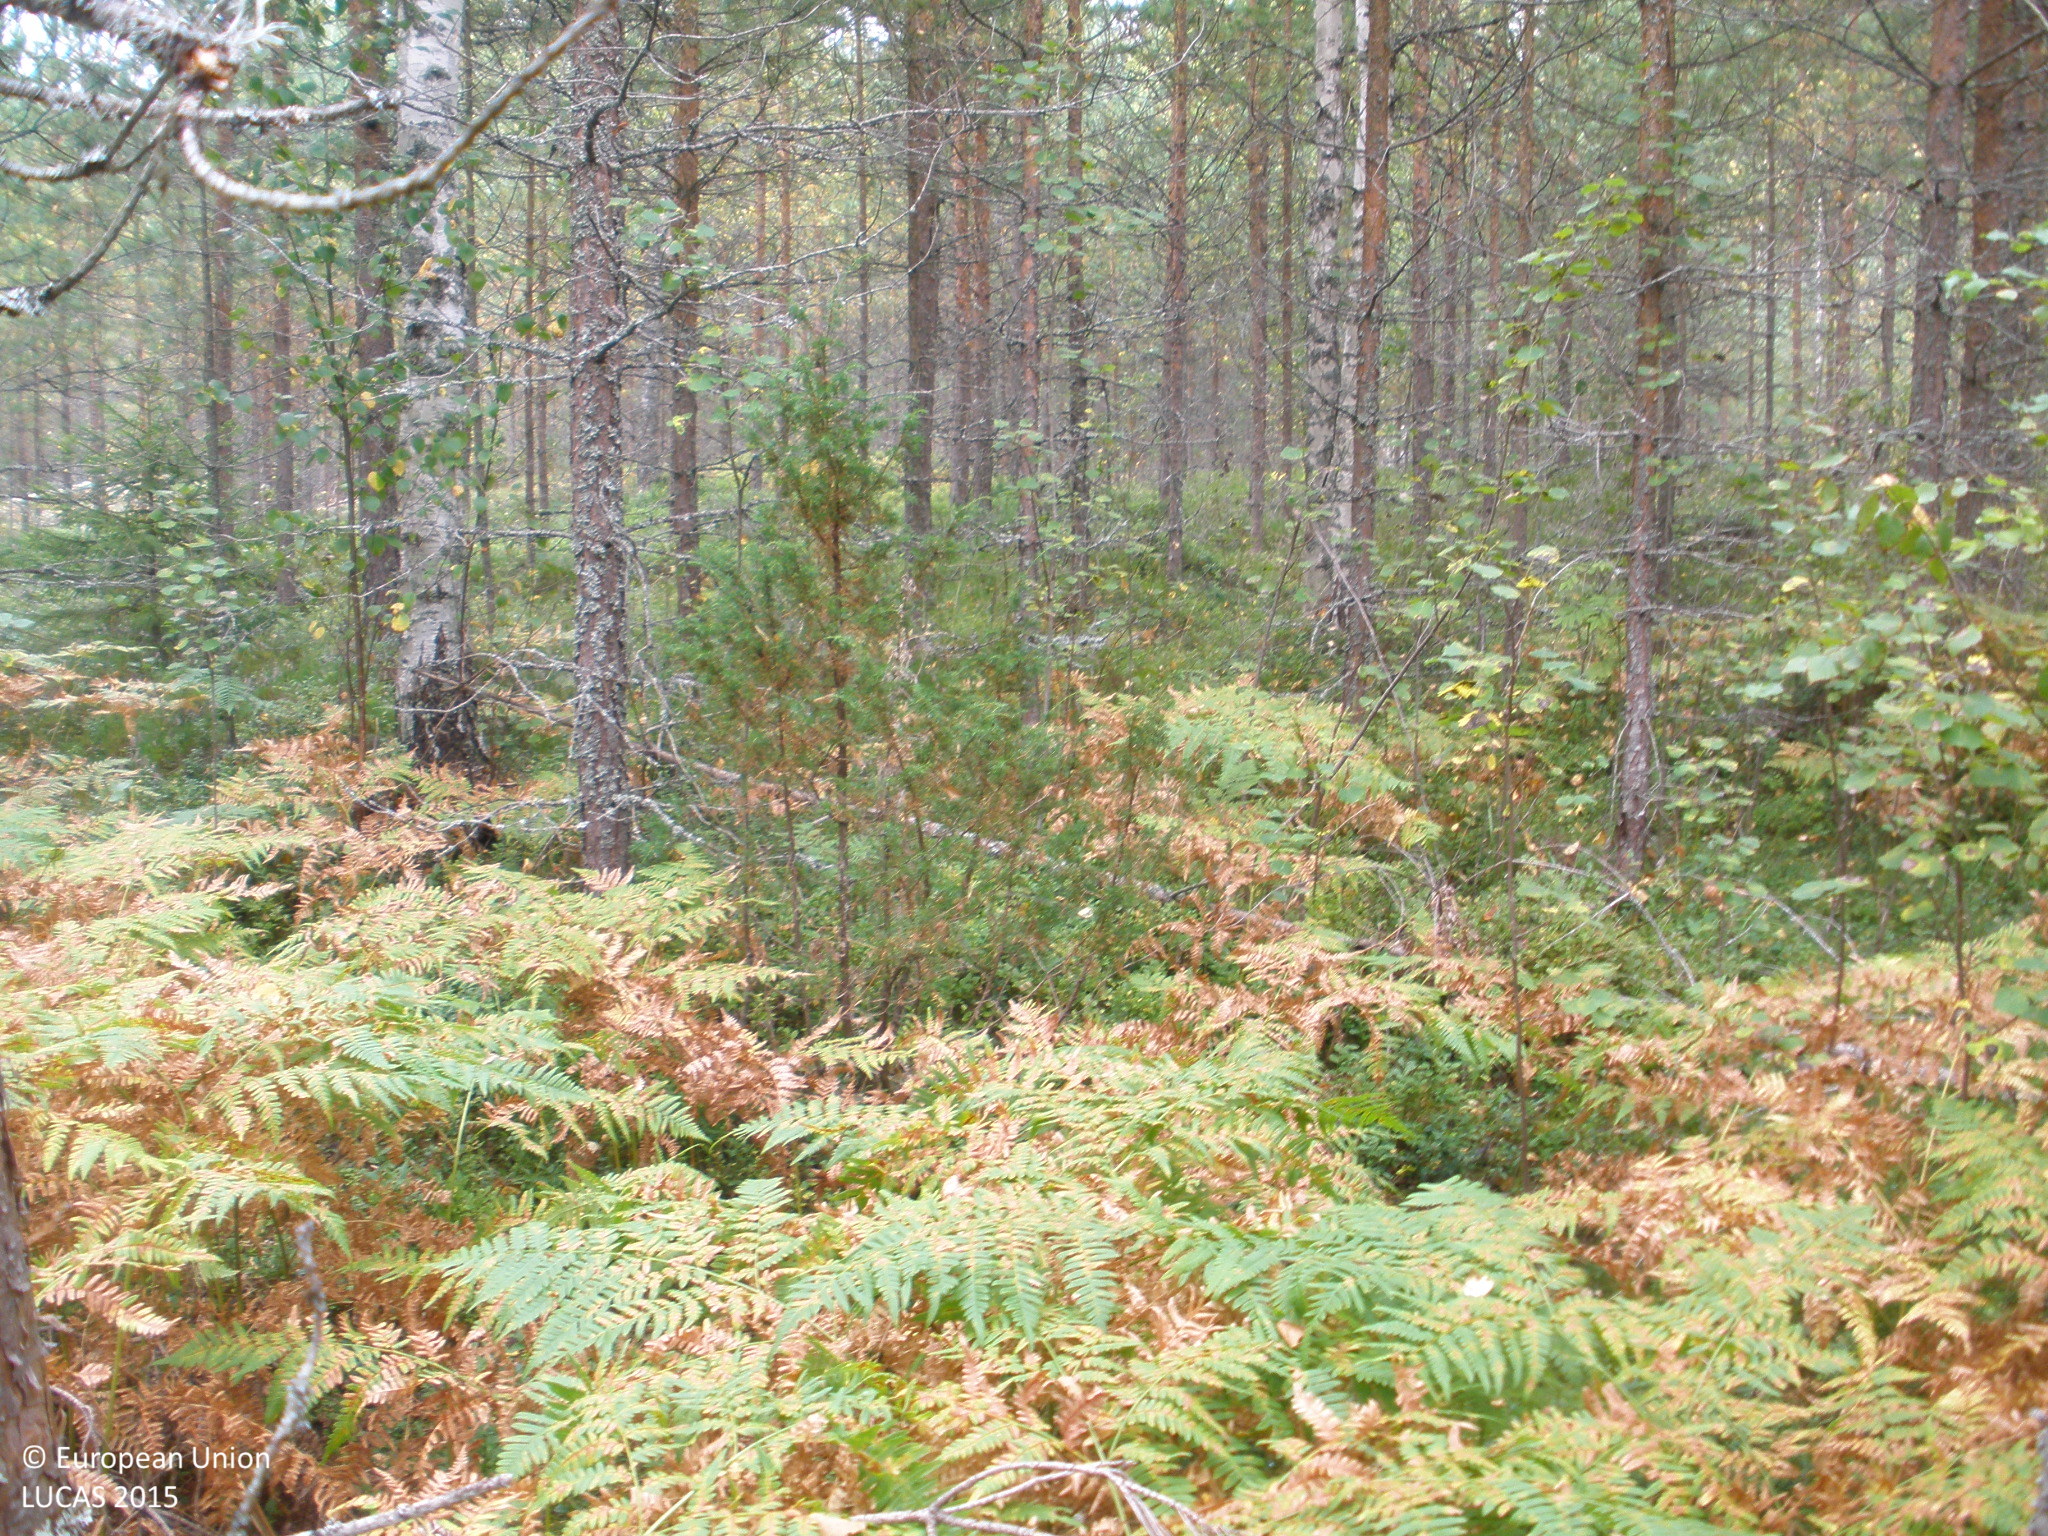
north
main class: Woodland
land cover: Pine dominated mixed woodland
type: boreal forest
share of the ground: > 75 %
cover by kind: coniferous forest trees 60 %, broadleaved forest trees 25 %, herbaceous plants 10 %, lichens and mosses 5 %
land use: Forestry
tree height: > 5 m
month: August
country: FI
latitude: 60.6033
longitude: 23.5471
